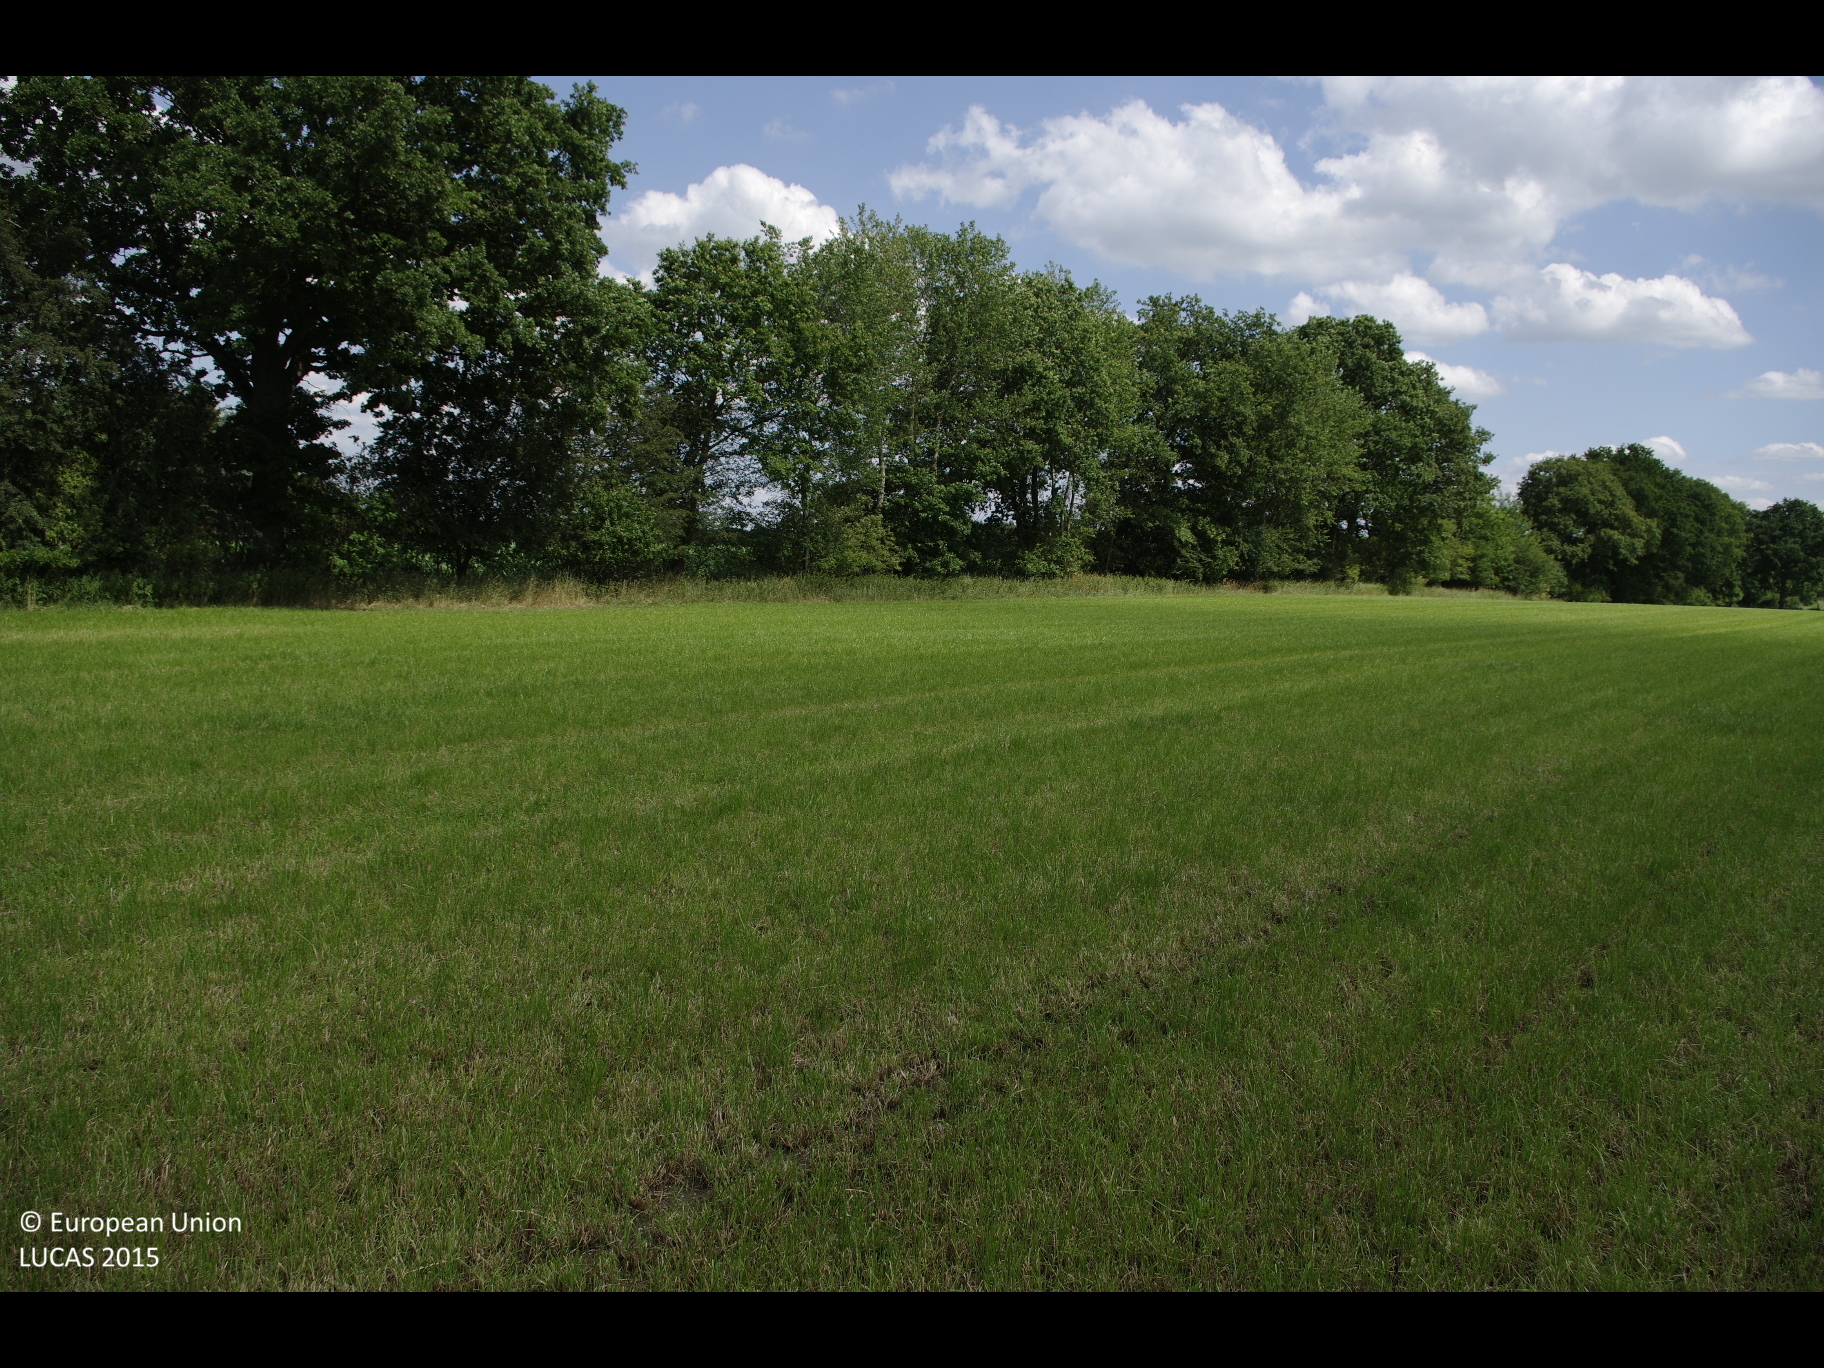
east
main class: Cropland
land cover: Temporary grasslands
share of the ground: > 75 %
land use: Agriculture (excluding fallow land and kitchen gardens)
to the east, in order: Temporary grasslands; Broadleaved woodland; Maize
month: July
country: DE
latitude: 53.8871
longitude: 9.8936
